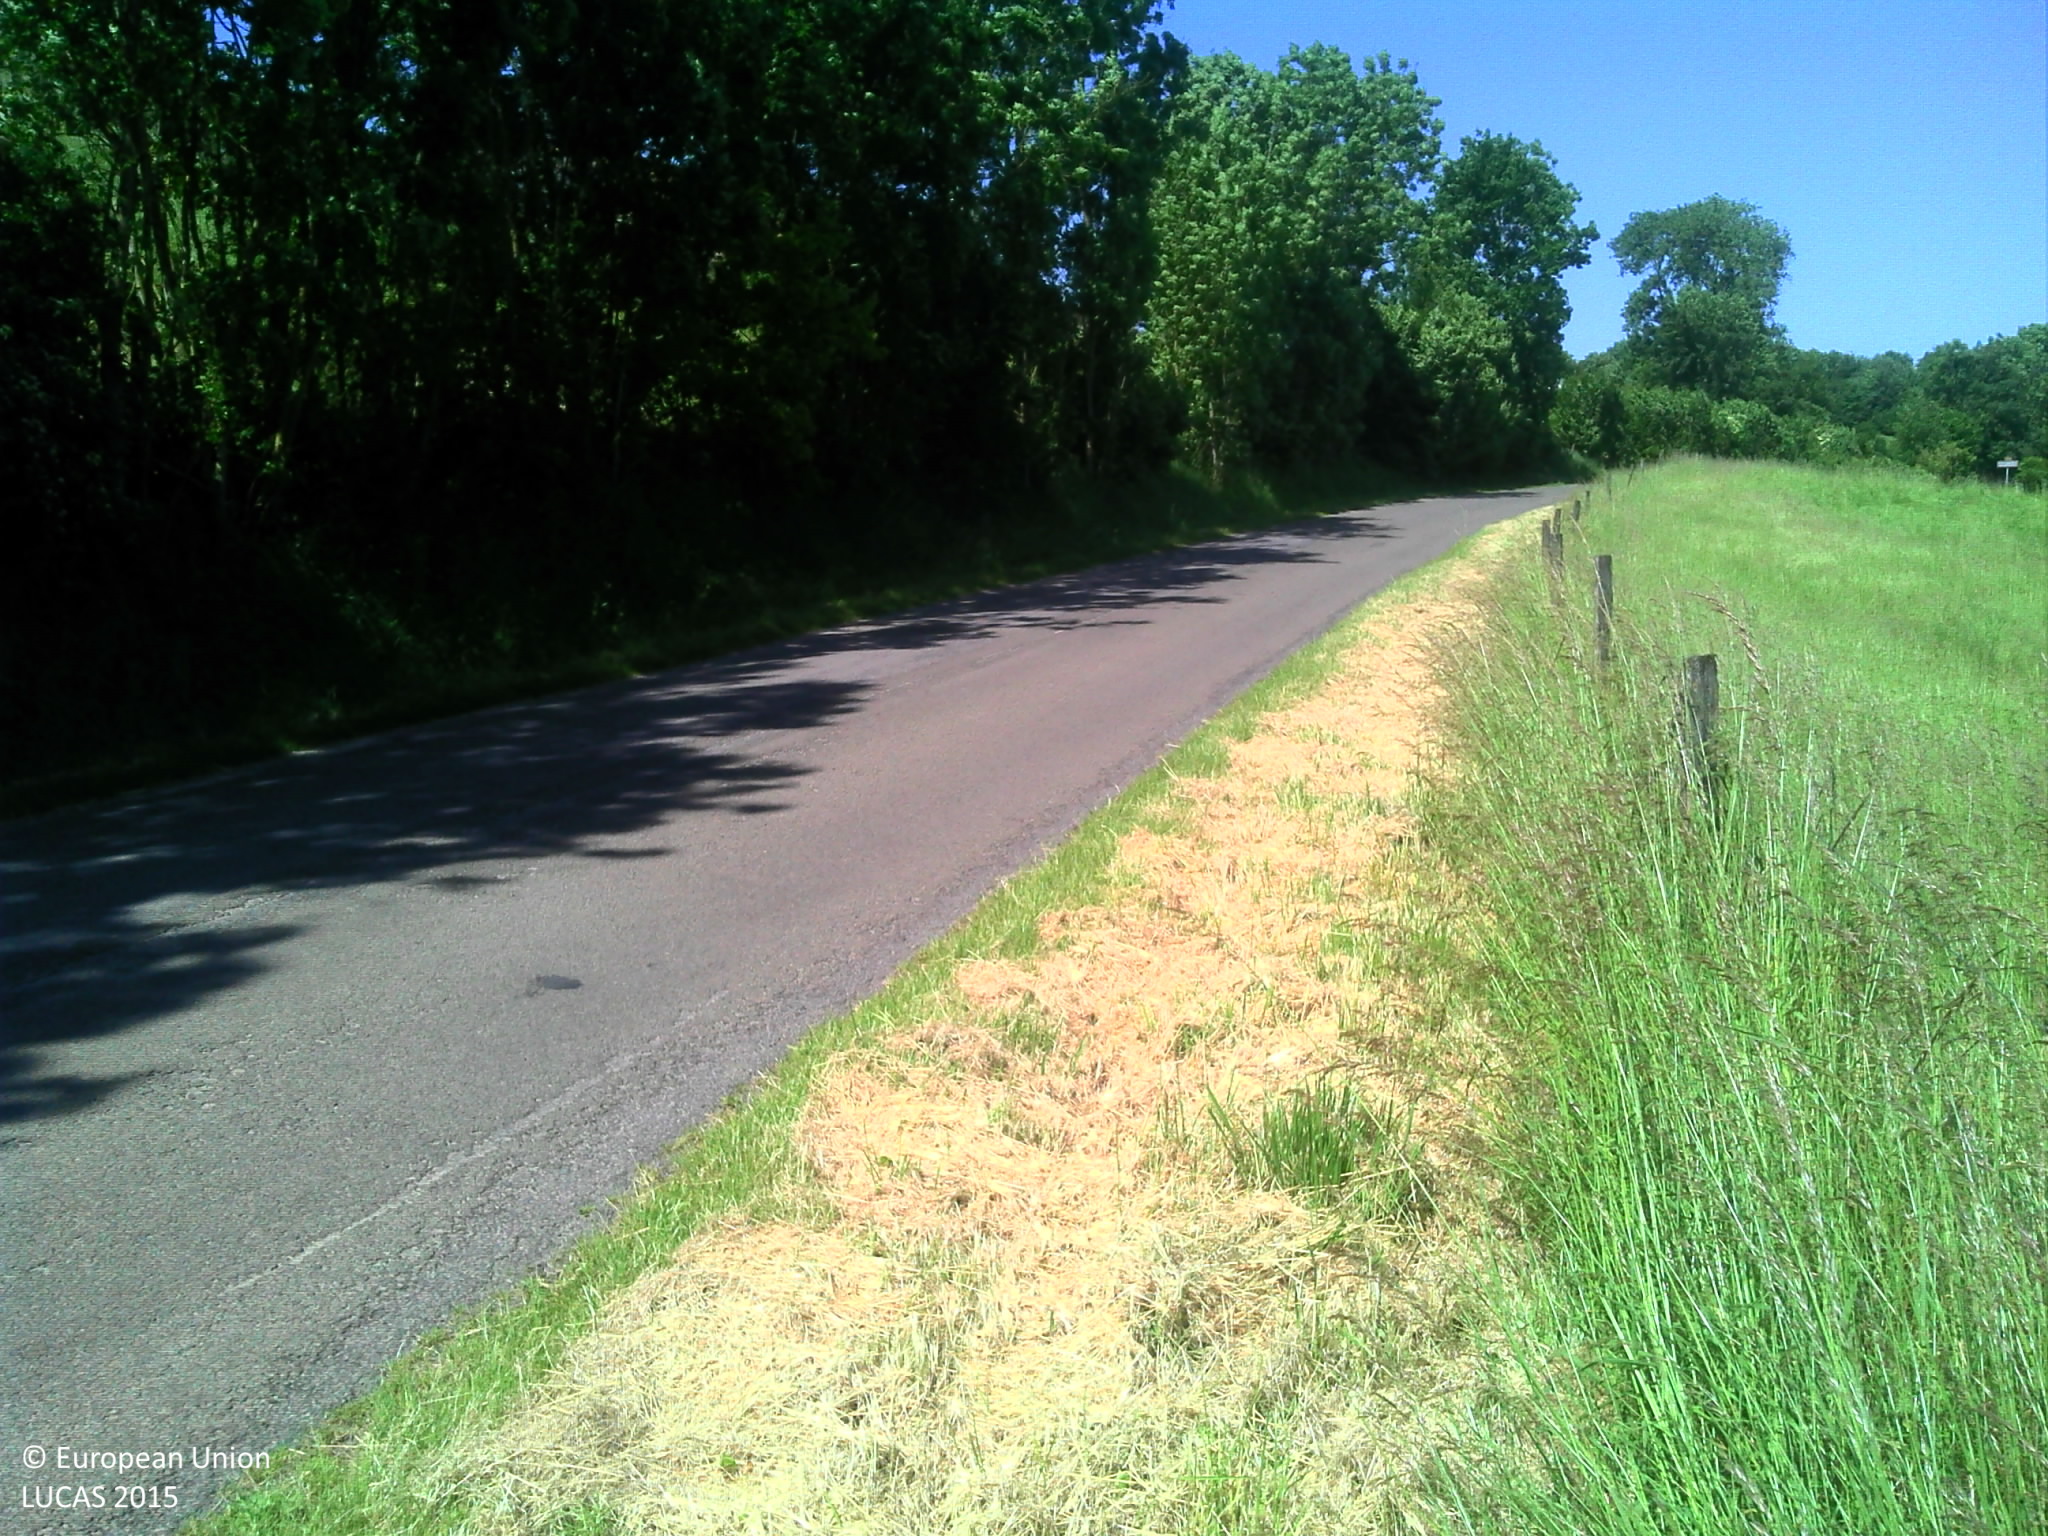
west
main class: Grassland
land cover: Grassland without tree/shrub cover
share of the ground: > 75 %
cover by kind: herbaceous plants 100 %
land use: Agriculture (excluding fallow land and kitchen gardens)
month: June
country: FR
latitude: 49.6697
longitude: 4.0783
